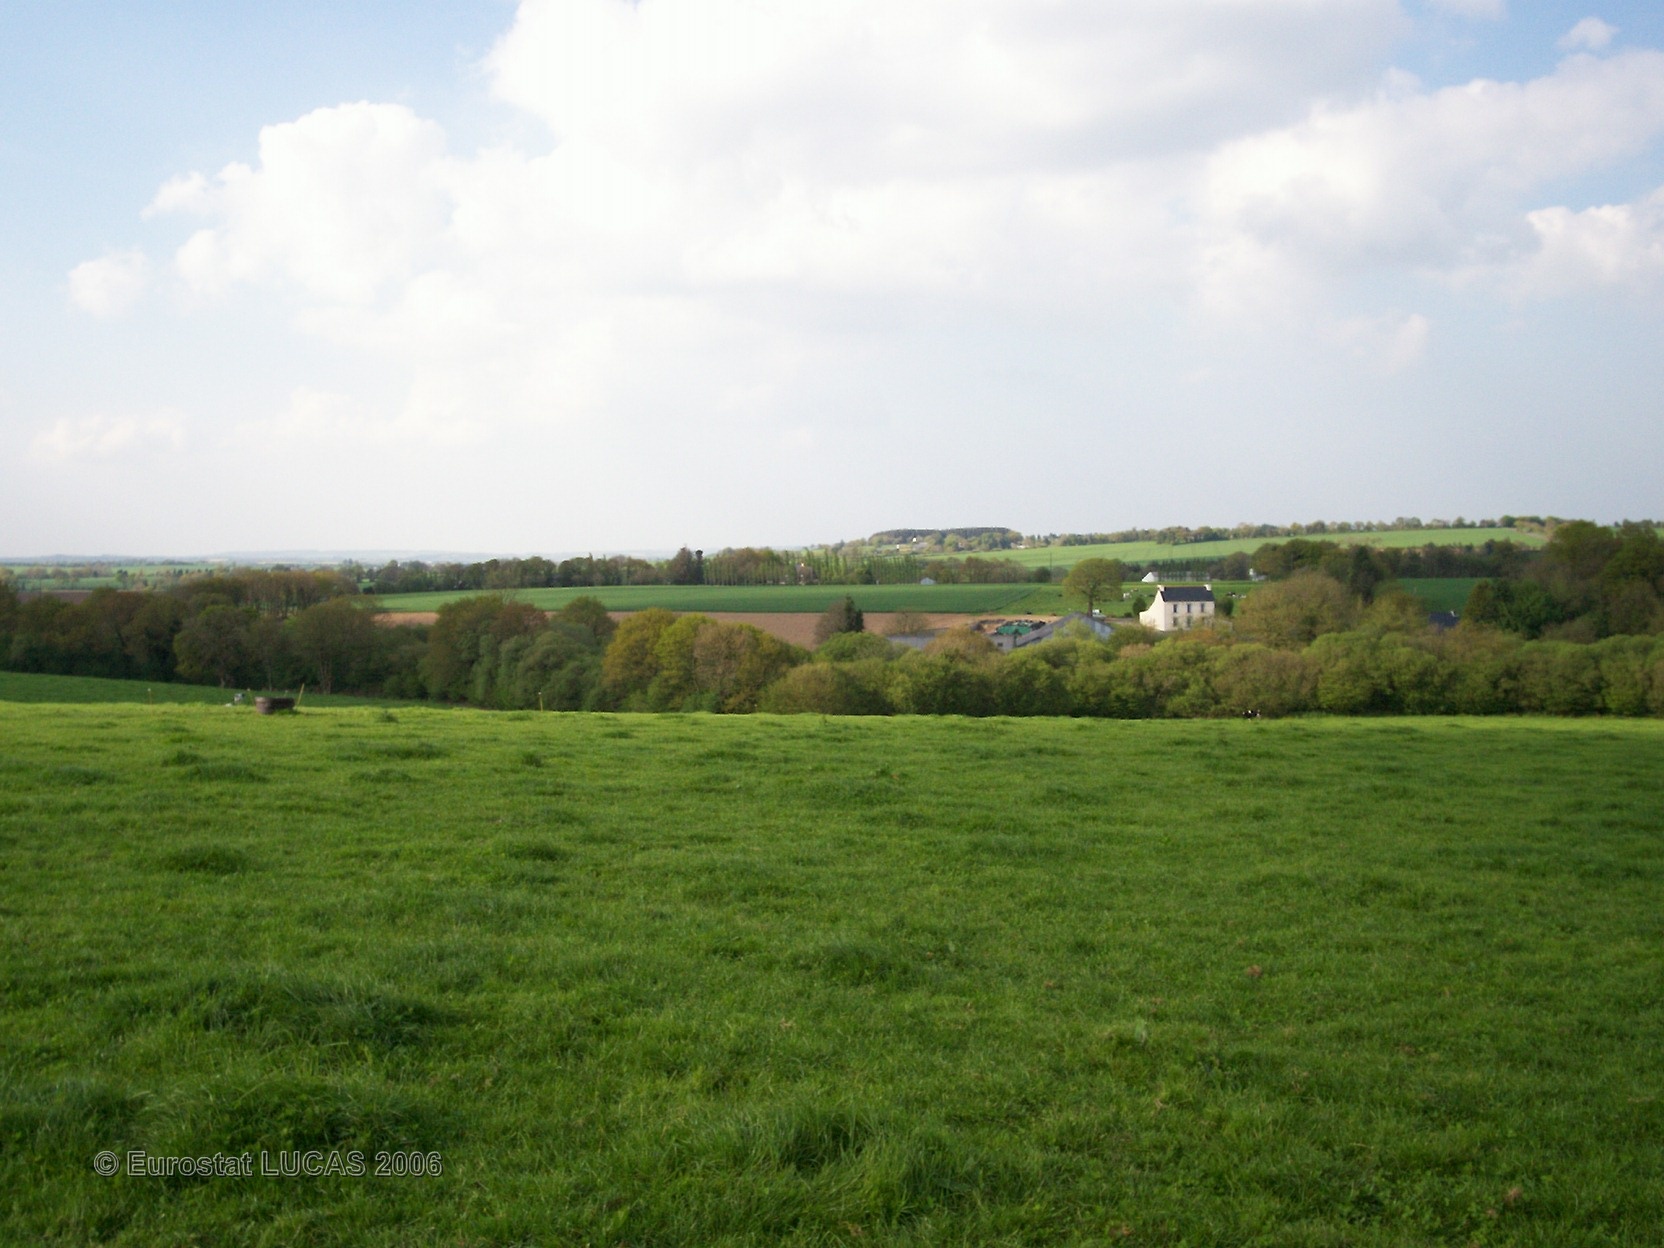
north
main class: Grassland
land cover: Grassland without tree/shrub cover
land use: Agriculture (excluding fallow land and kitchen gardens)
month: May
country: FR
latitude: 48.3413
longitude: -3.6125
